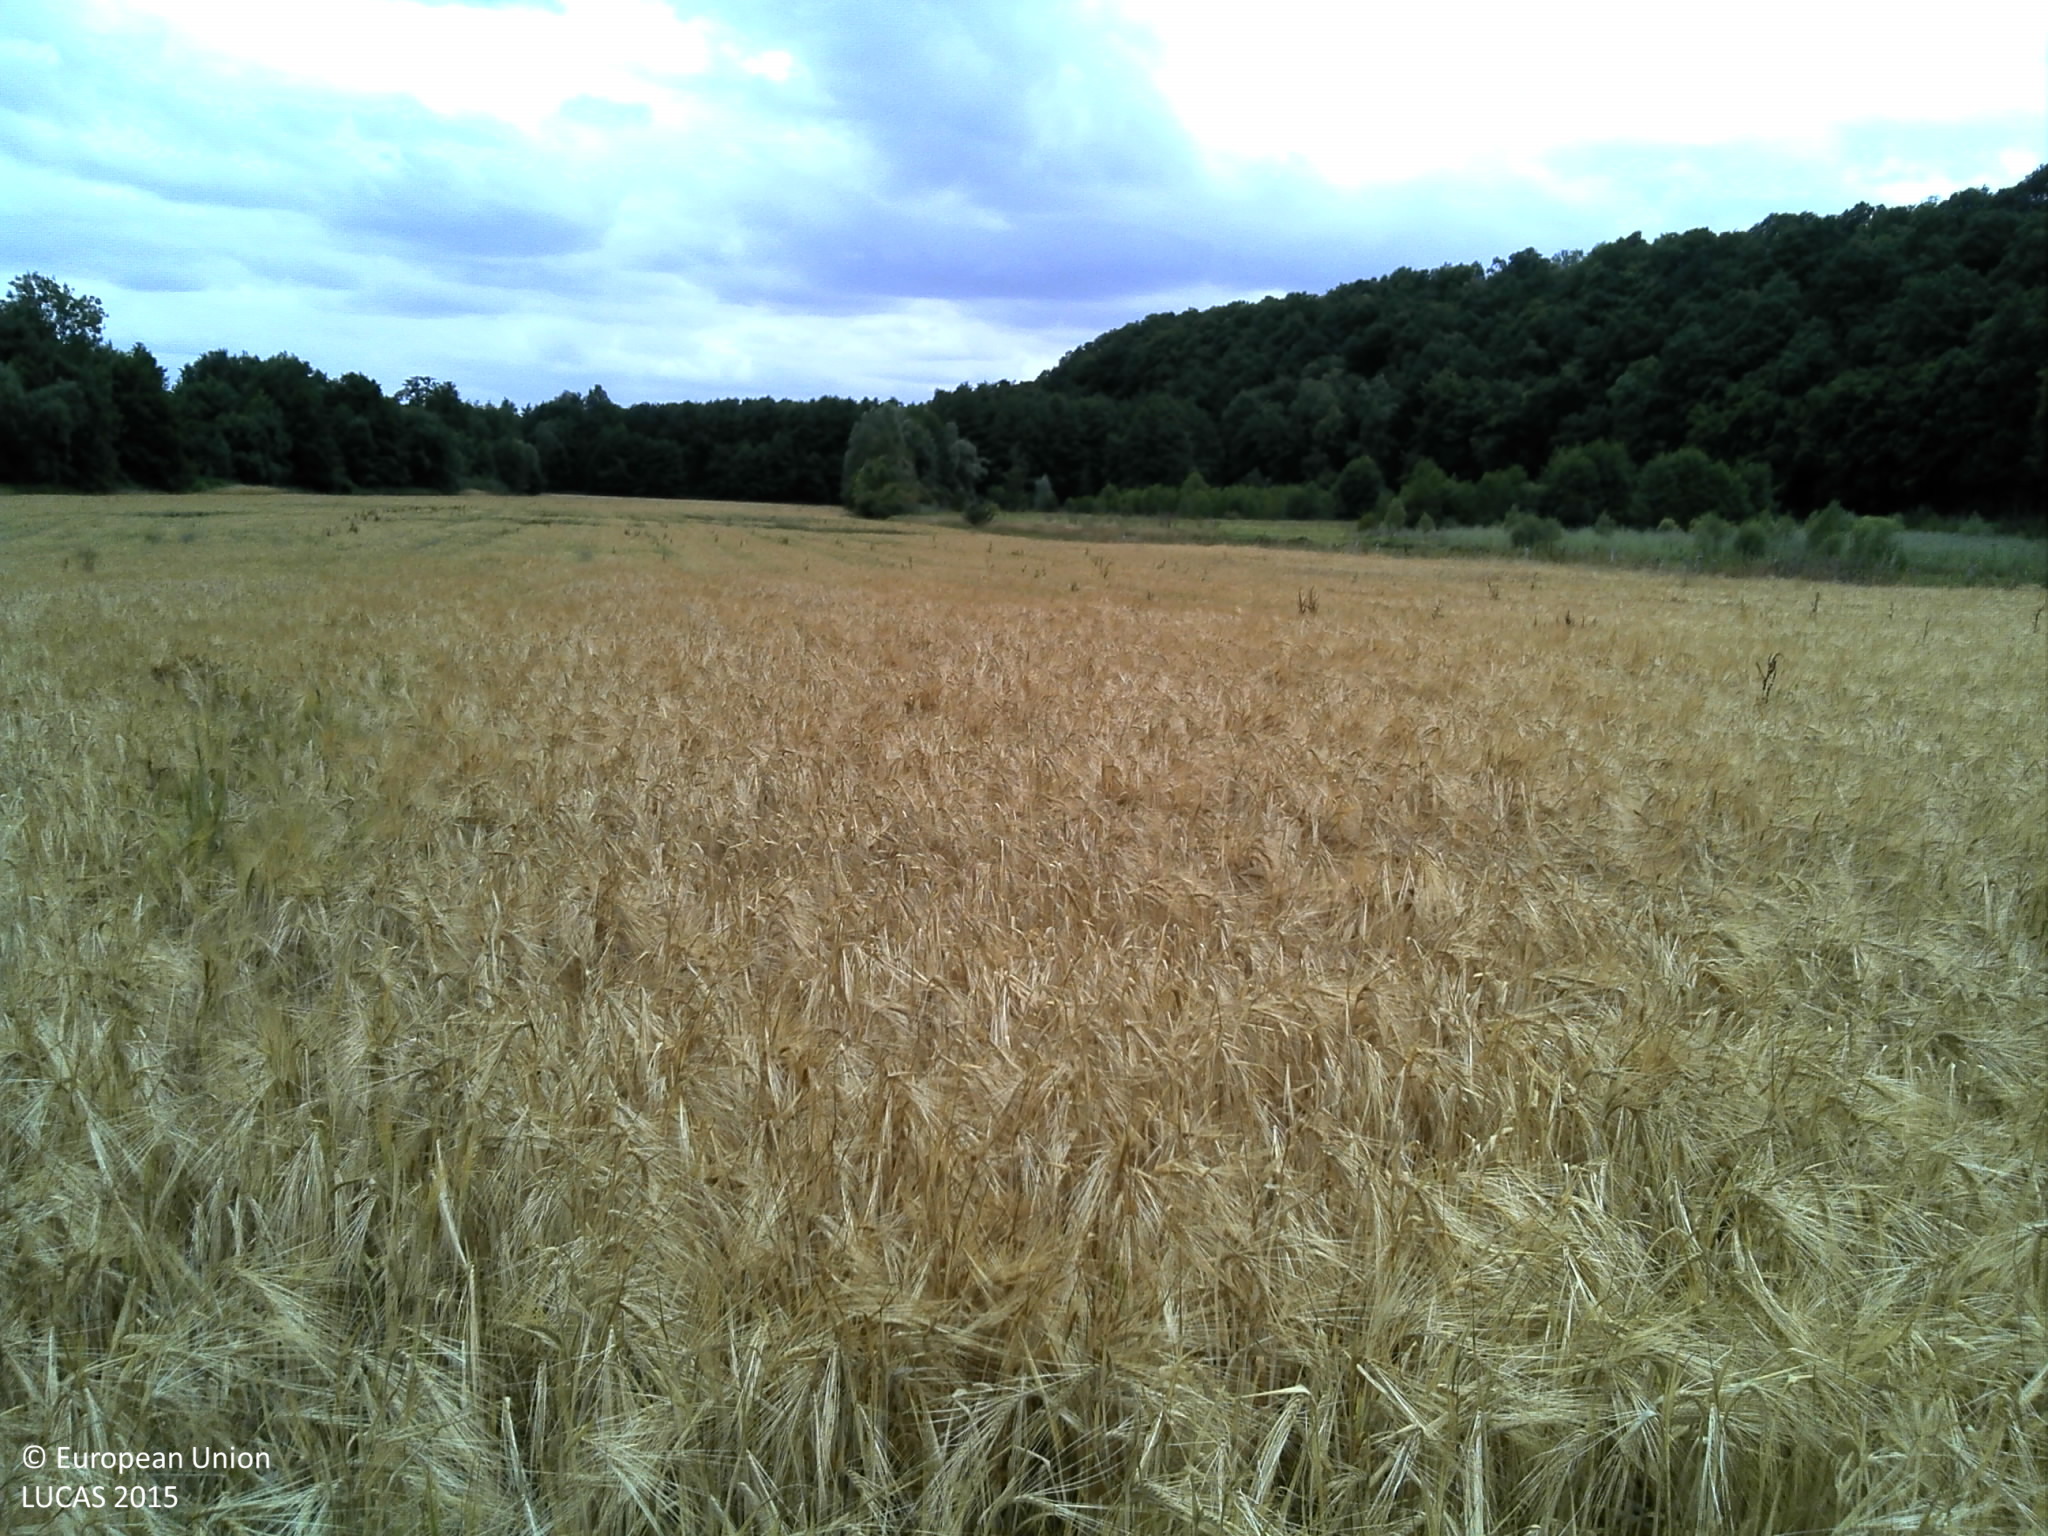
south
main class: Cropland
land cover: Rye
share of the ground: > 75 %
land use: Agriculture (excluding fallow land and kitchen gardens)
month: July
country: FR
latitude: 49.1862
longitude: 4.8798
